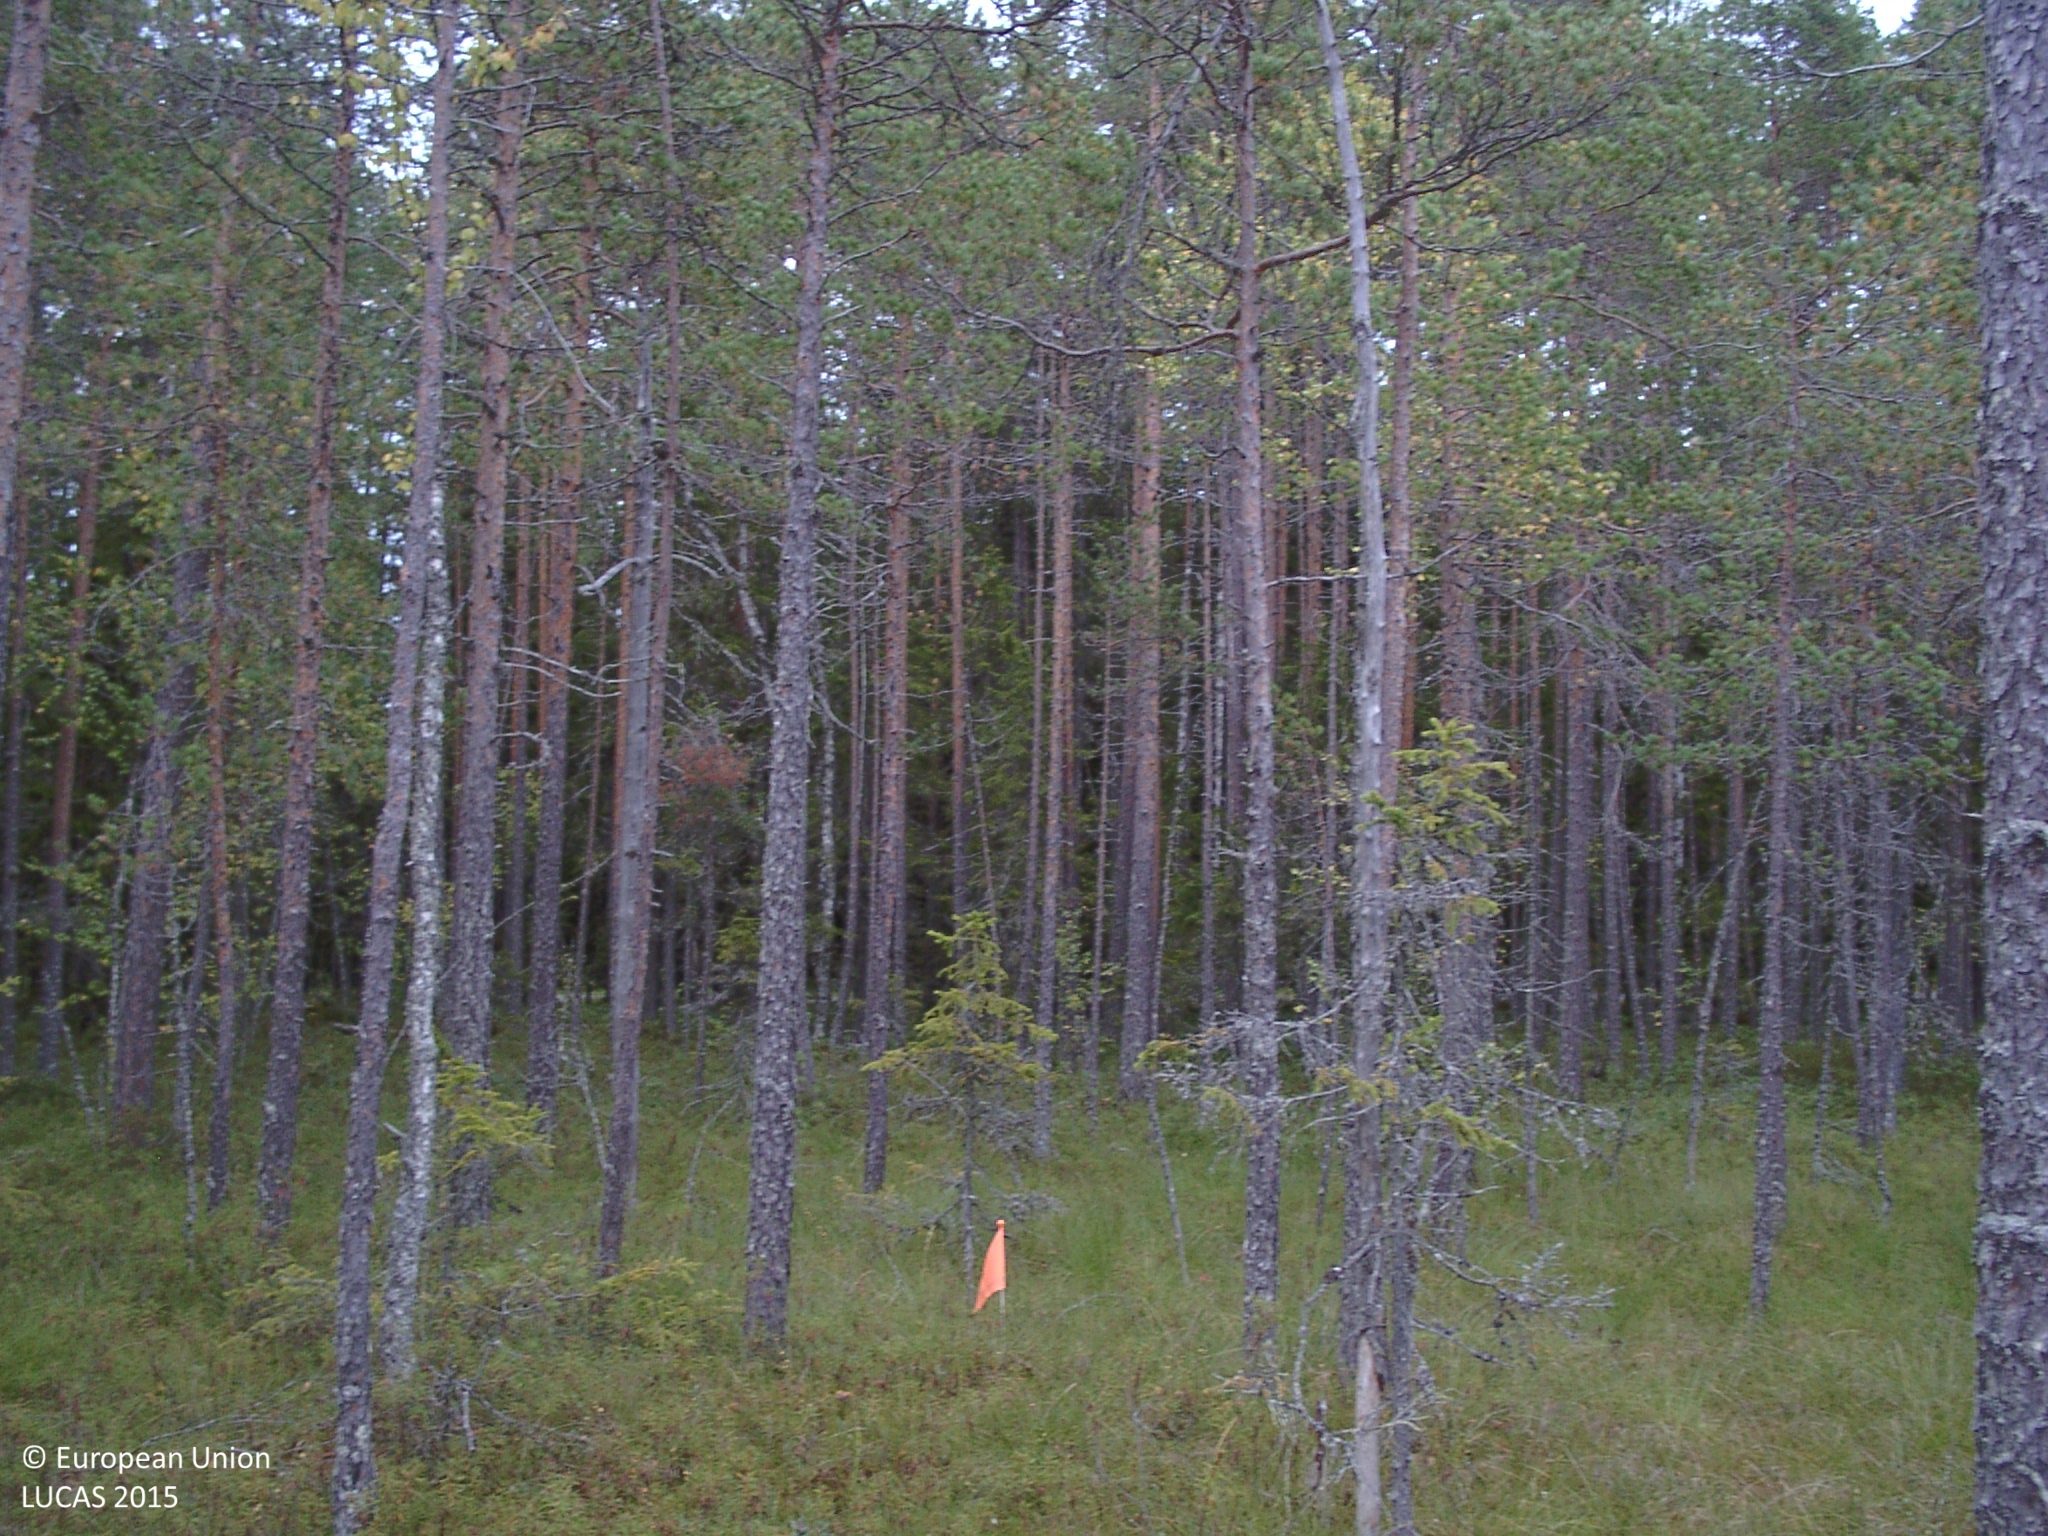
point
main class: Woodland
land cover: Pine dominated coniferous woodland
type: mire and swamp forests
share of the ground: 25 - 50 %
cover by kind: coniferous forest trees 45 %, shrubs 20 %, herbaceous plants 20 %, lichens and mosses 15 %
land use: Amenities, museums, leisure
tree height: > 5 m
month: September
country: FI
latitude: 62.8549
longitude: 25.4910
